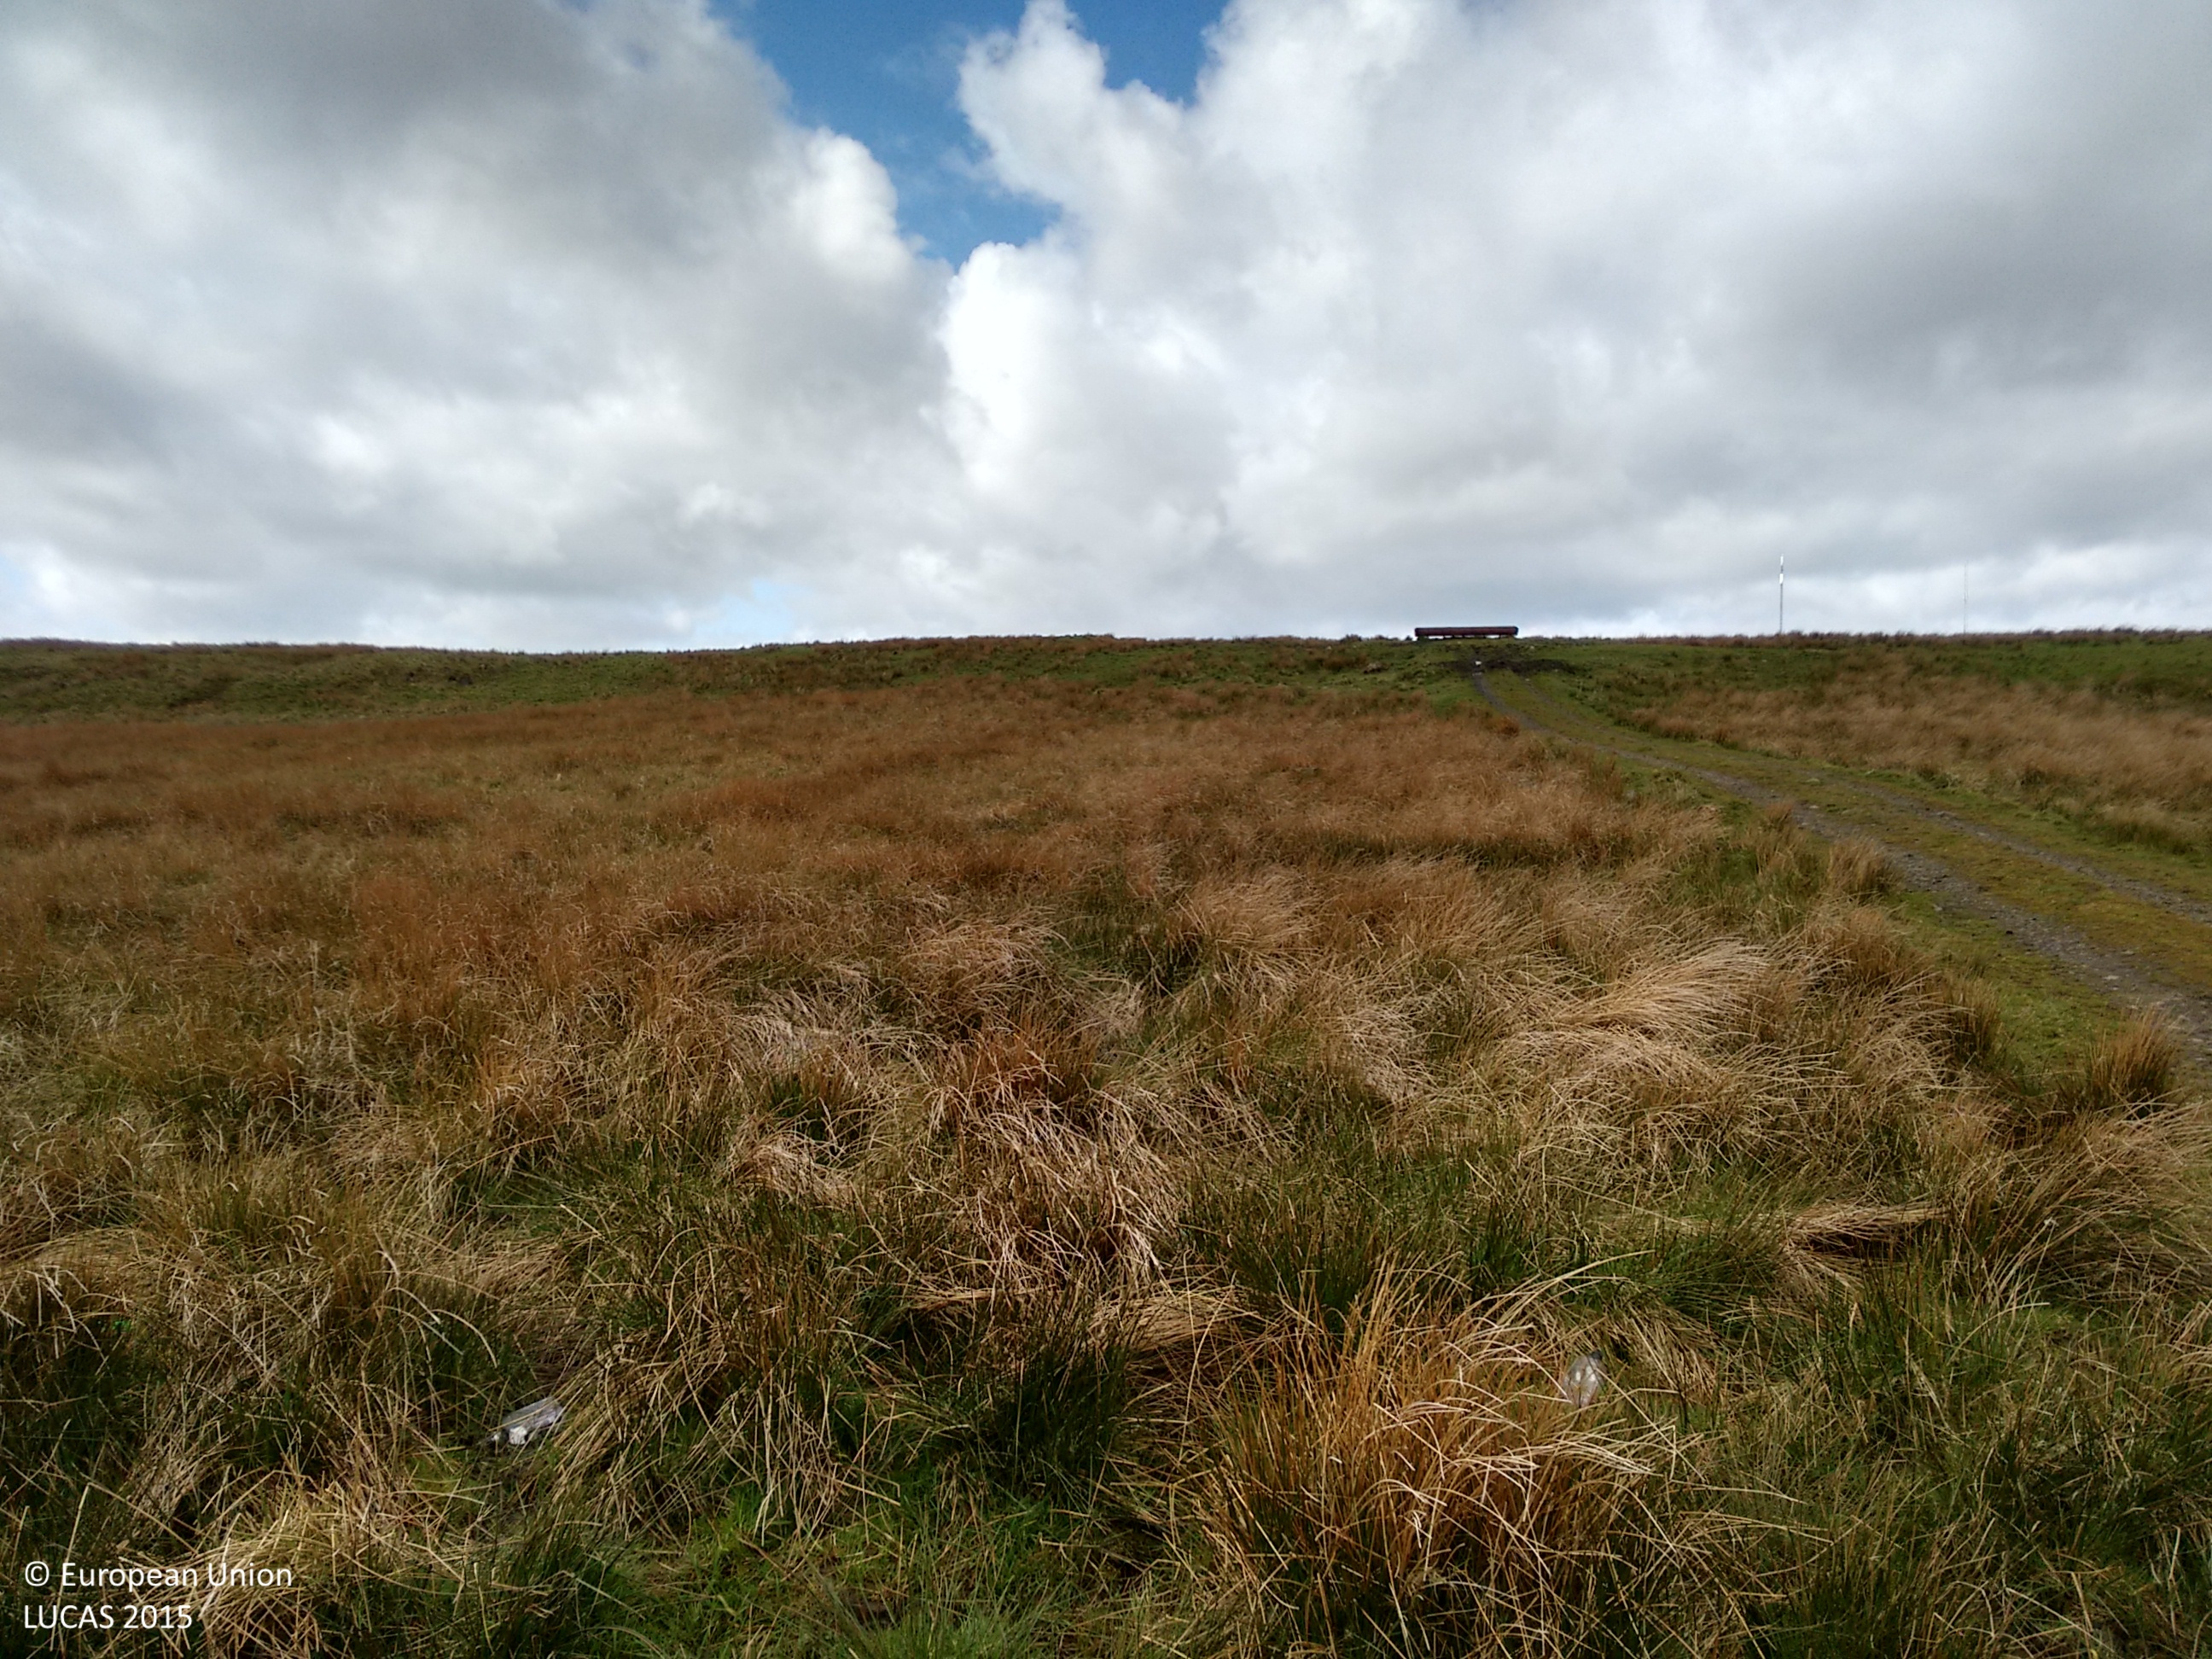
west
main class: Grassland
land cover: Grassland without tree/shrub cover
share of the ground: > 75 %
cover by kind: herbaceous plants 100 %
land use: Agriculture (excluding fallow land and kitchen gardens)
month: May
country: GB
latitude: 55.8743
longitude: -3.8132
